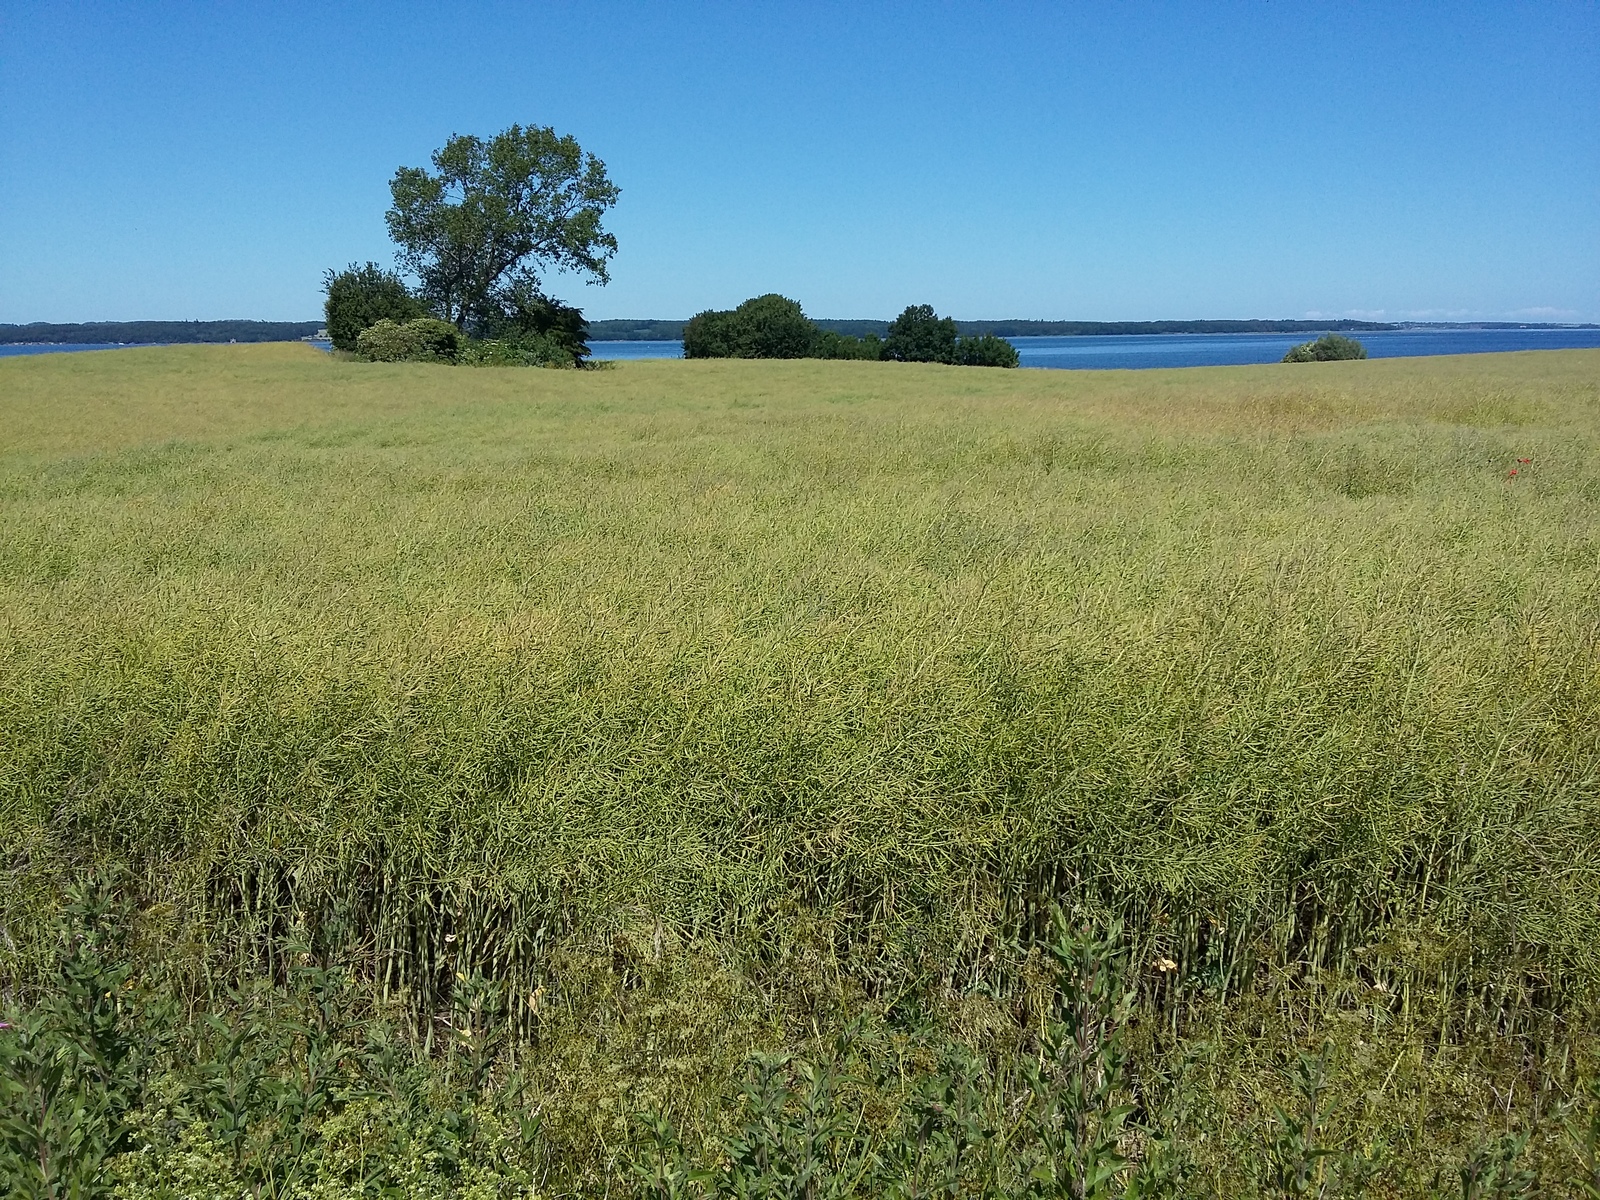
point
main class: Cropland
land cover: Rape and turnip rape
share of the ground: > 75 %
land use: Agriculture (excluding fallow land and kitchen gardens)
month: July
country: DK
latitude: 54.9314
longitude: 12.0119
